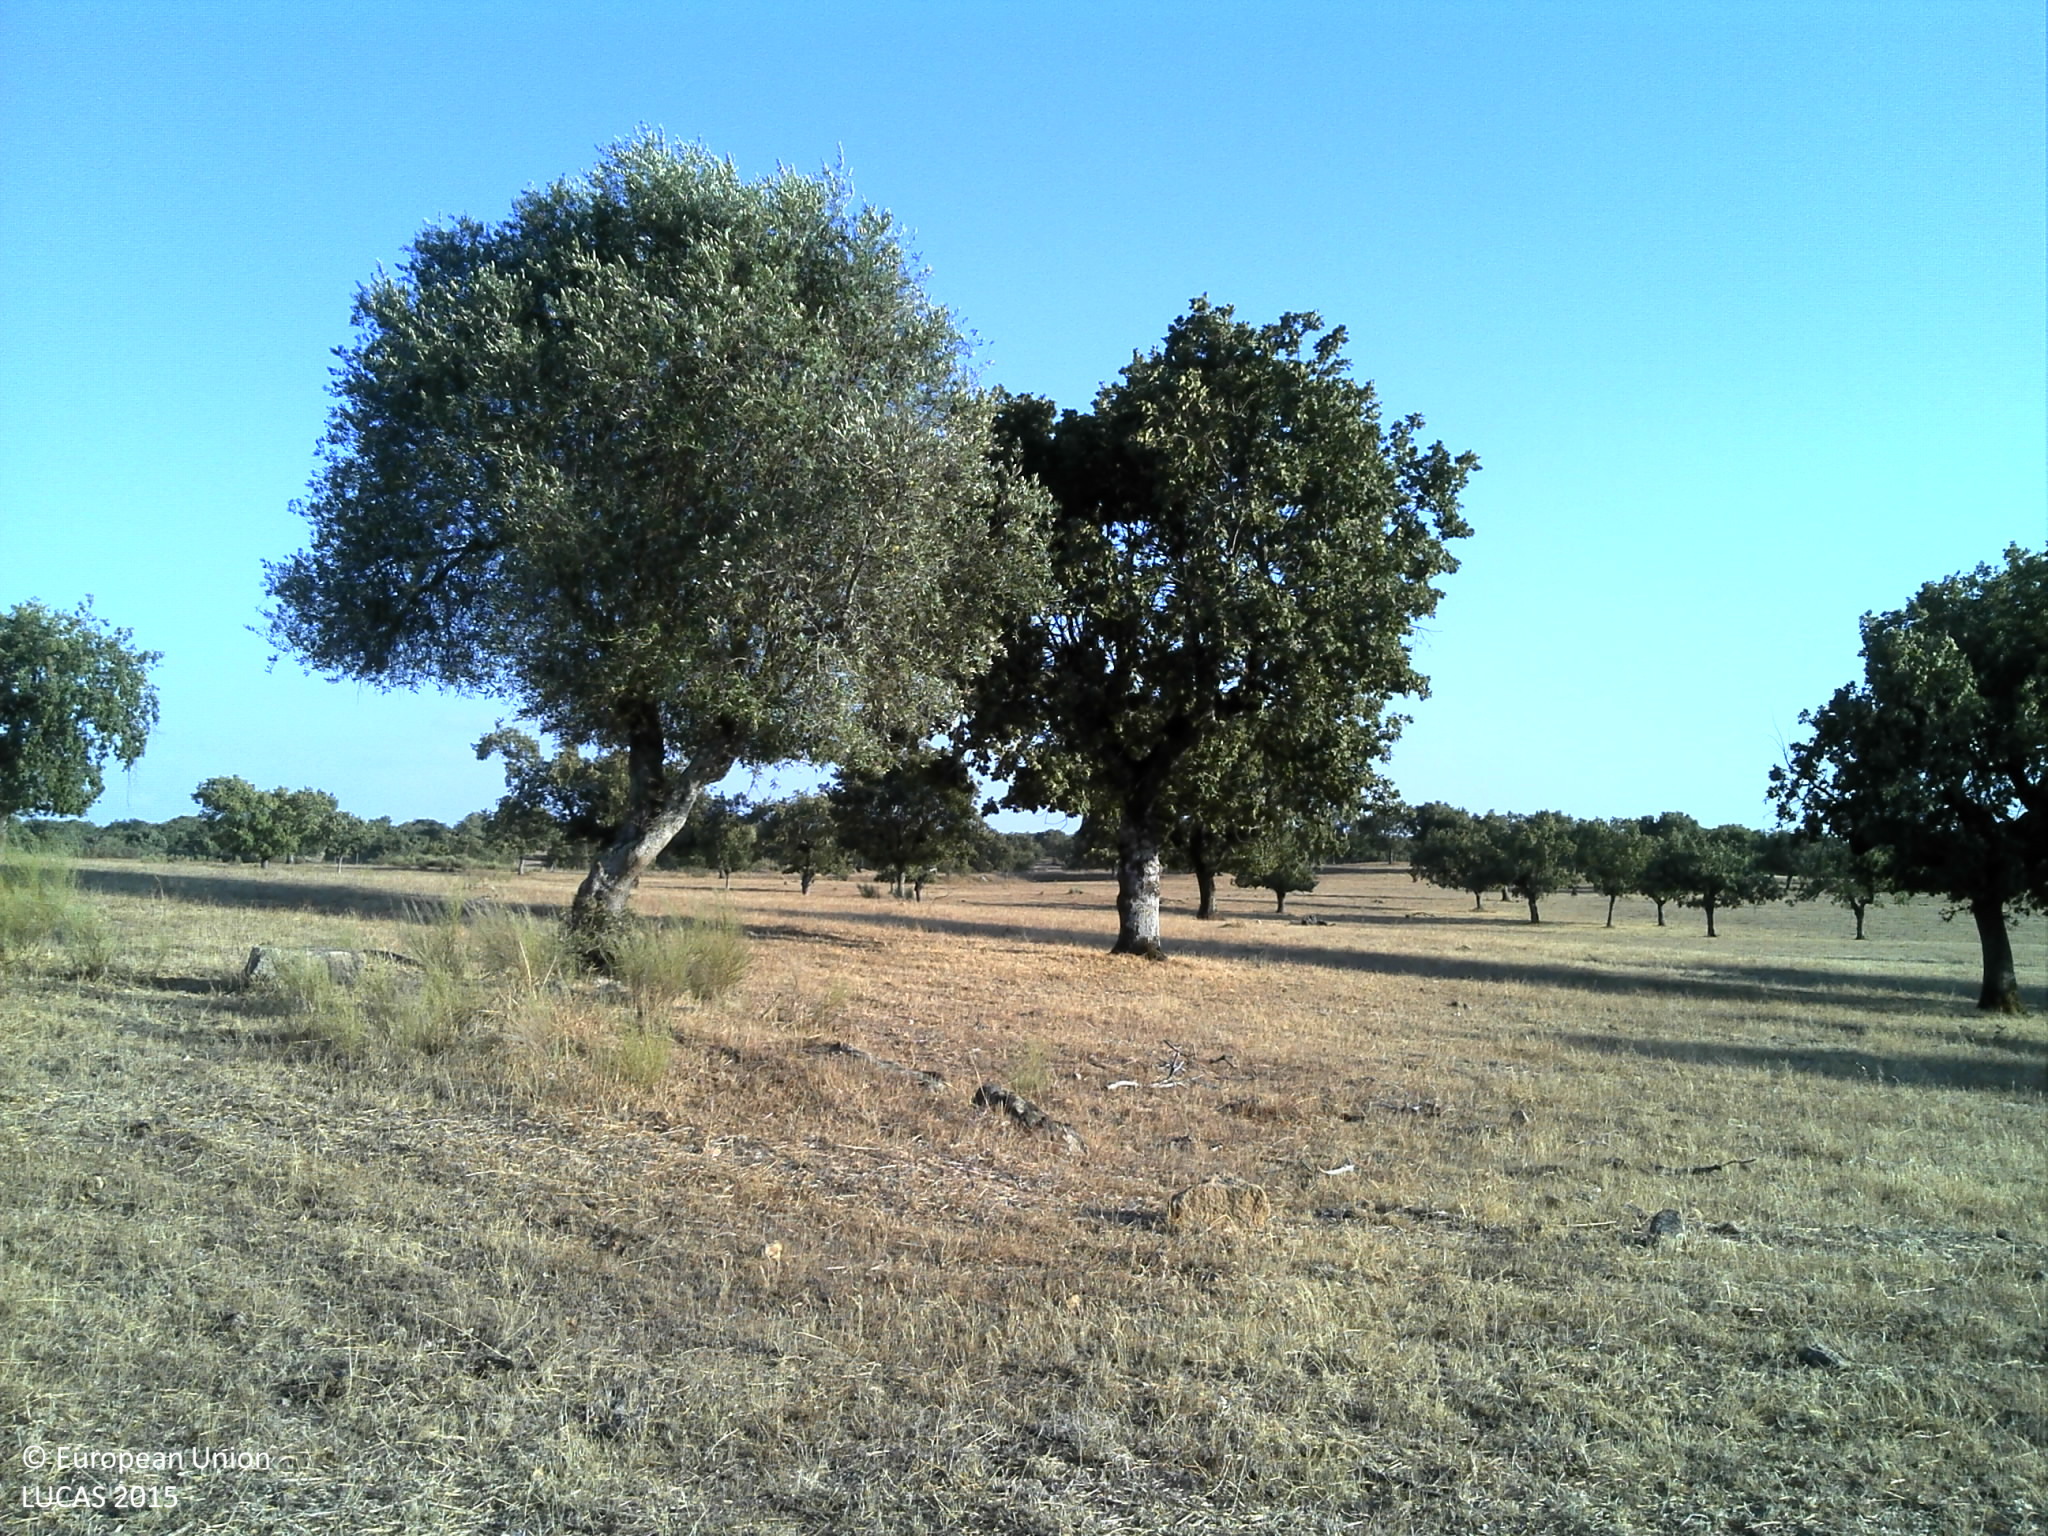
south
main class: Woodland
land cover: Broadleaved woodland
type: broadleaved evergreen forest
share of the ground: 10 - 25 %
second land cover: Grassland without tree/shrub cover
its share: 10 - 25 %
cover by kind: unconsolidated bare surface 80 %, broadleaved forest trees 10 %, herbaceous plants 10 %
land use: Forestry
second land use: Agriculture (excluding fallow land and kitchen gardens)
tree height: > 5 m
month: August
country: PT
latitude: 39.3533
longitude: -7.5569
